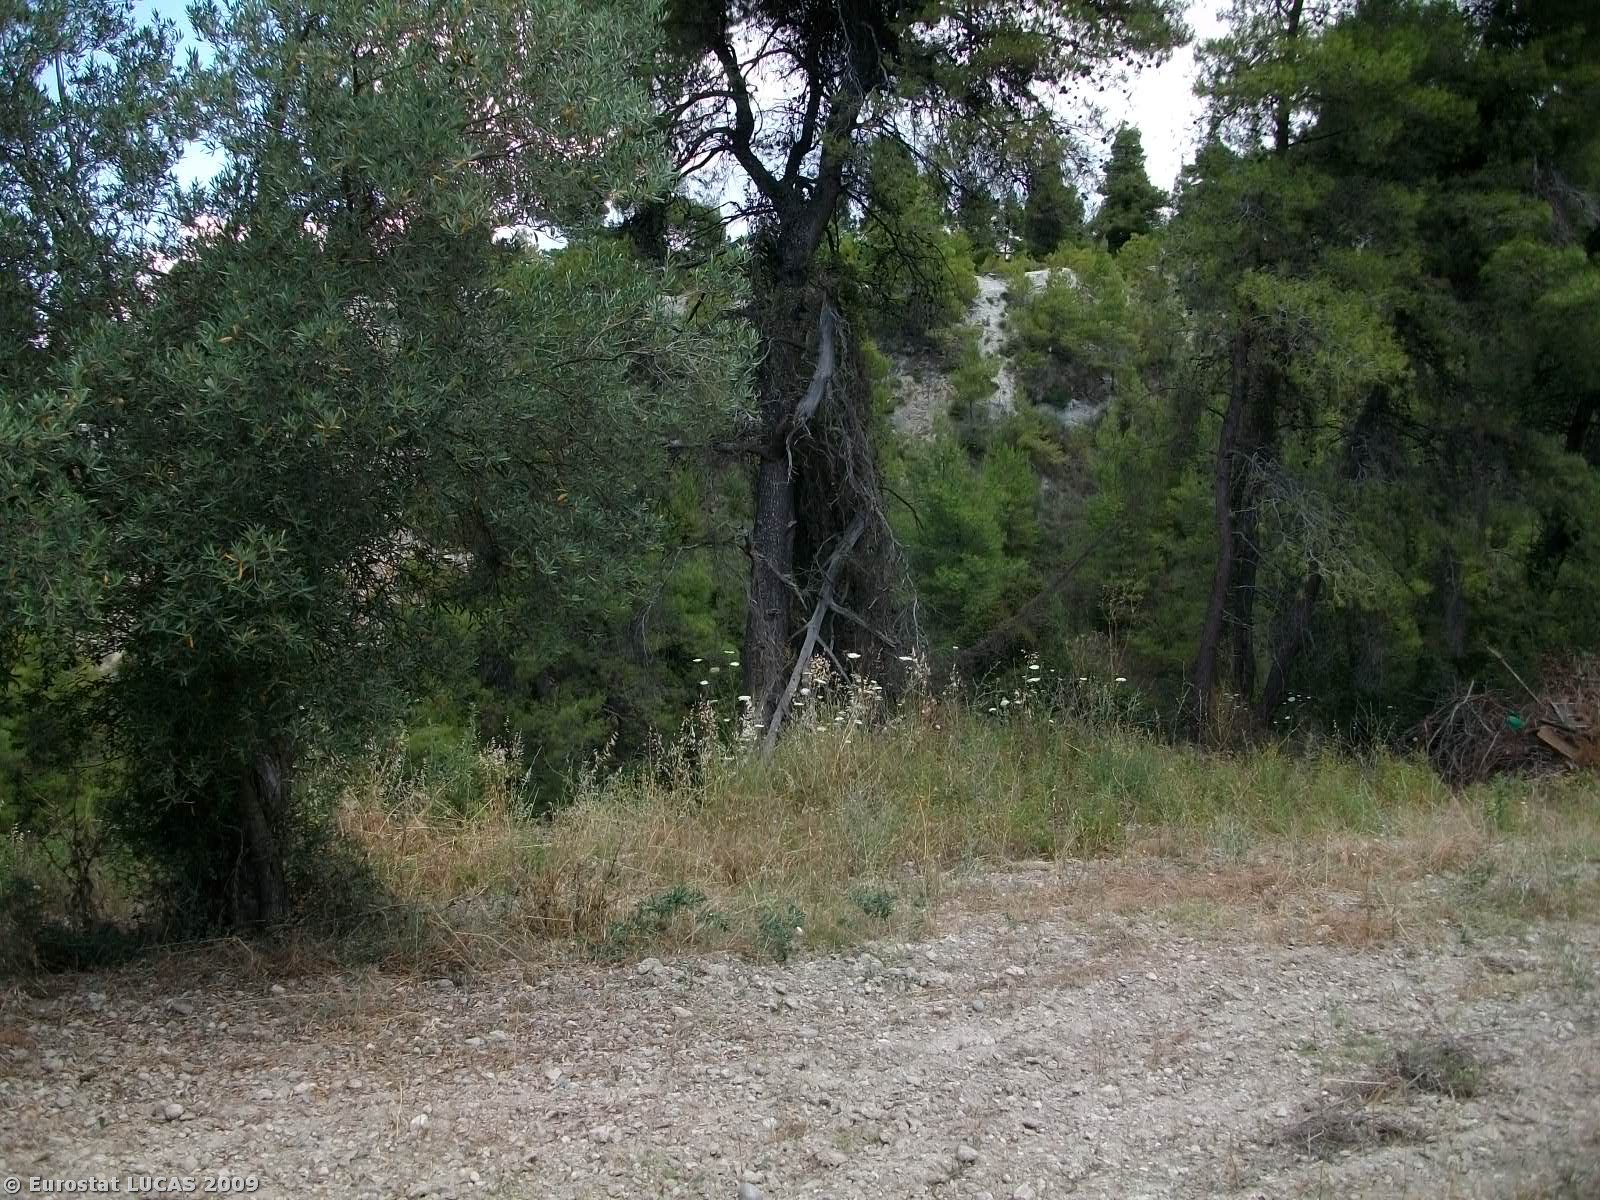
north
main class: Cropland
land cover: Olive groves
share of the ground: 10 - 25 %
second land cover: Bare land
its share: > 75 %
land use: Agriculture (excluding fallow land and kitchen gardens)
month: June
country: GR
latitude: 40.0004
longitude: 23.4168
